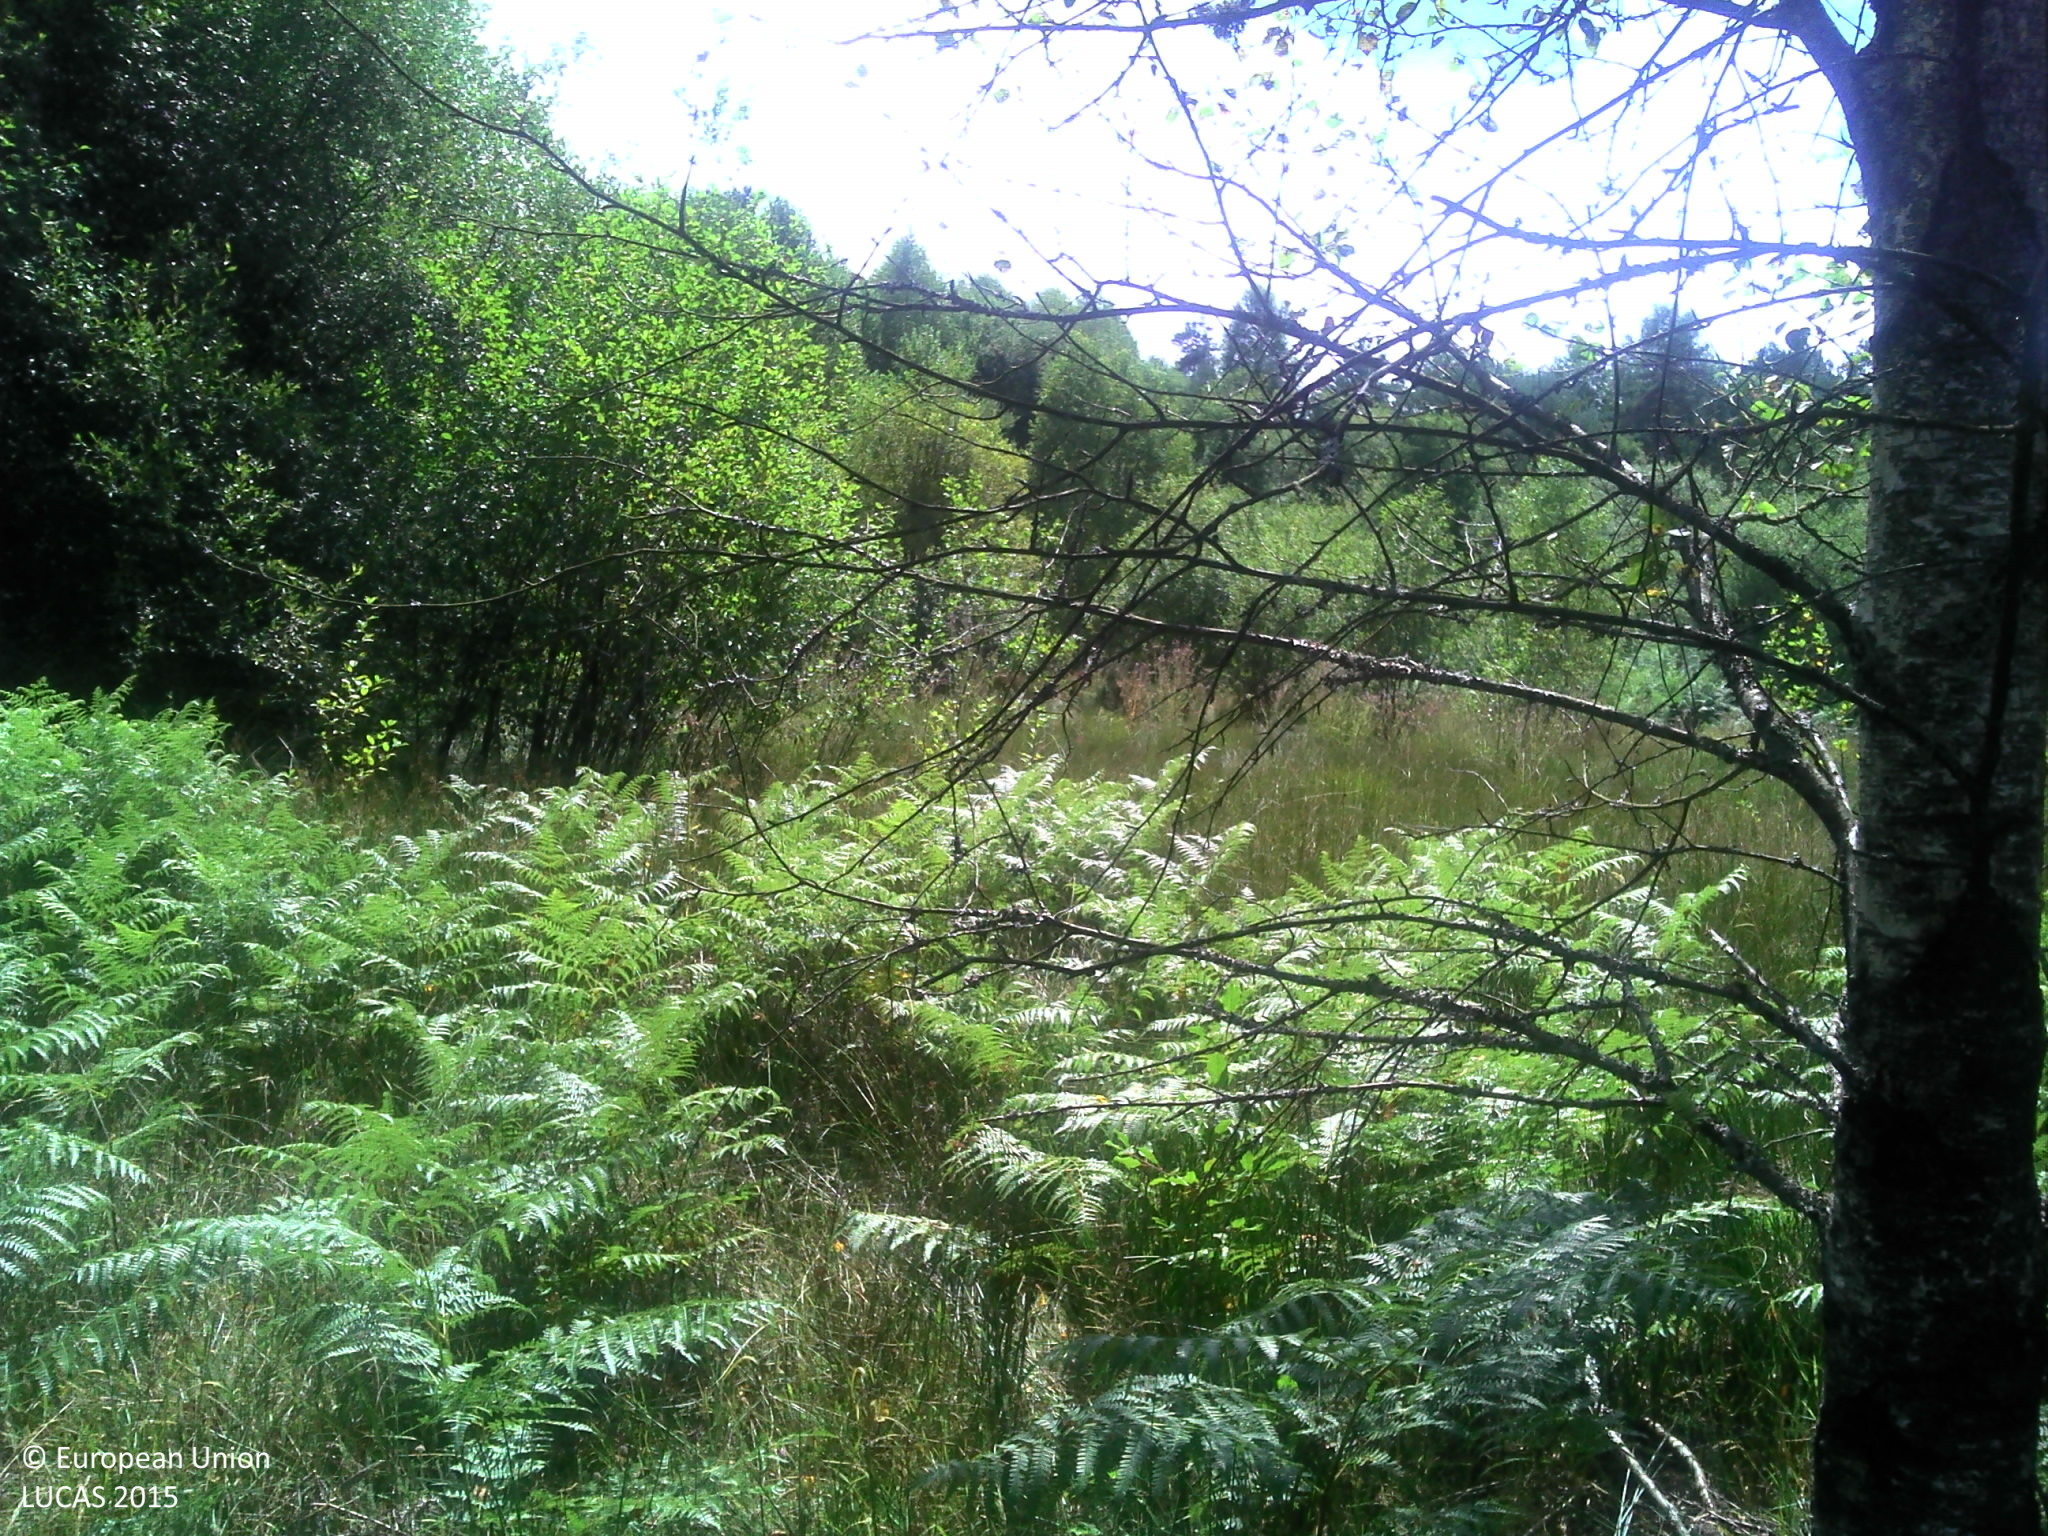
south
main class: Woodland
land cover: Broadleaved woodland
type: non-riverine alder, birch or aspen forest
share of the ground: > 75 %
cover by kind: shrubs 45 %, broadleaved forest trees 35 %, herbaceous plants 20 %
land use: Semi-natural and natural areas not in use
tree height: > 5 m
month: July
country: FR
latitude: 45.6236
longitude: 1.8507
